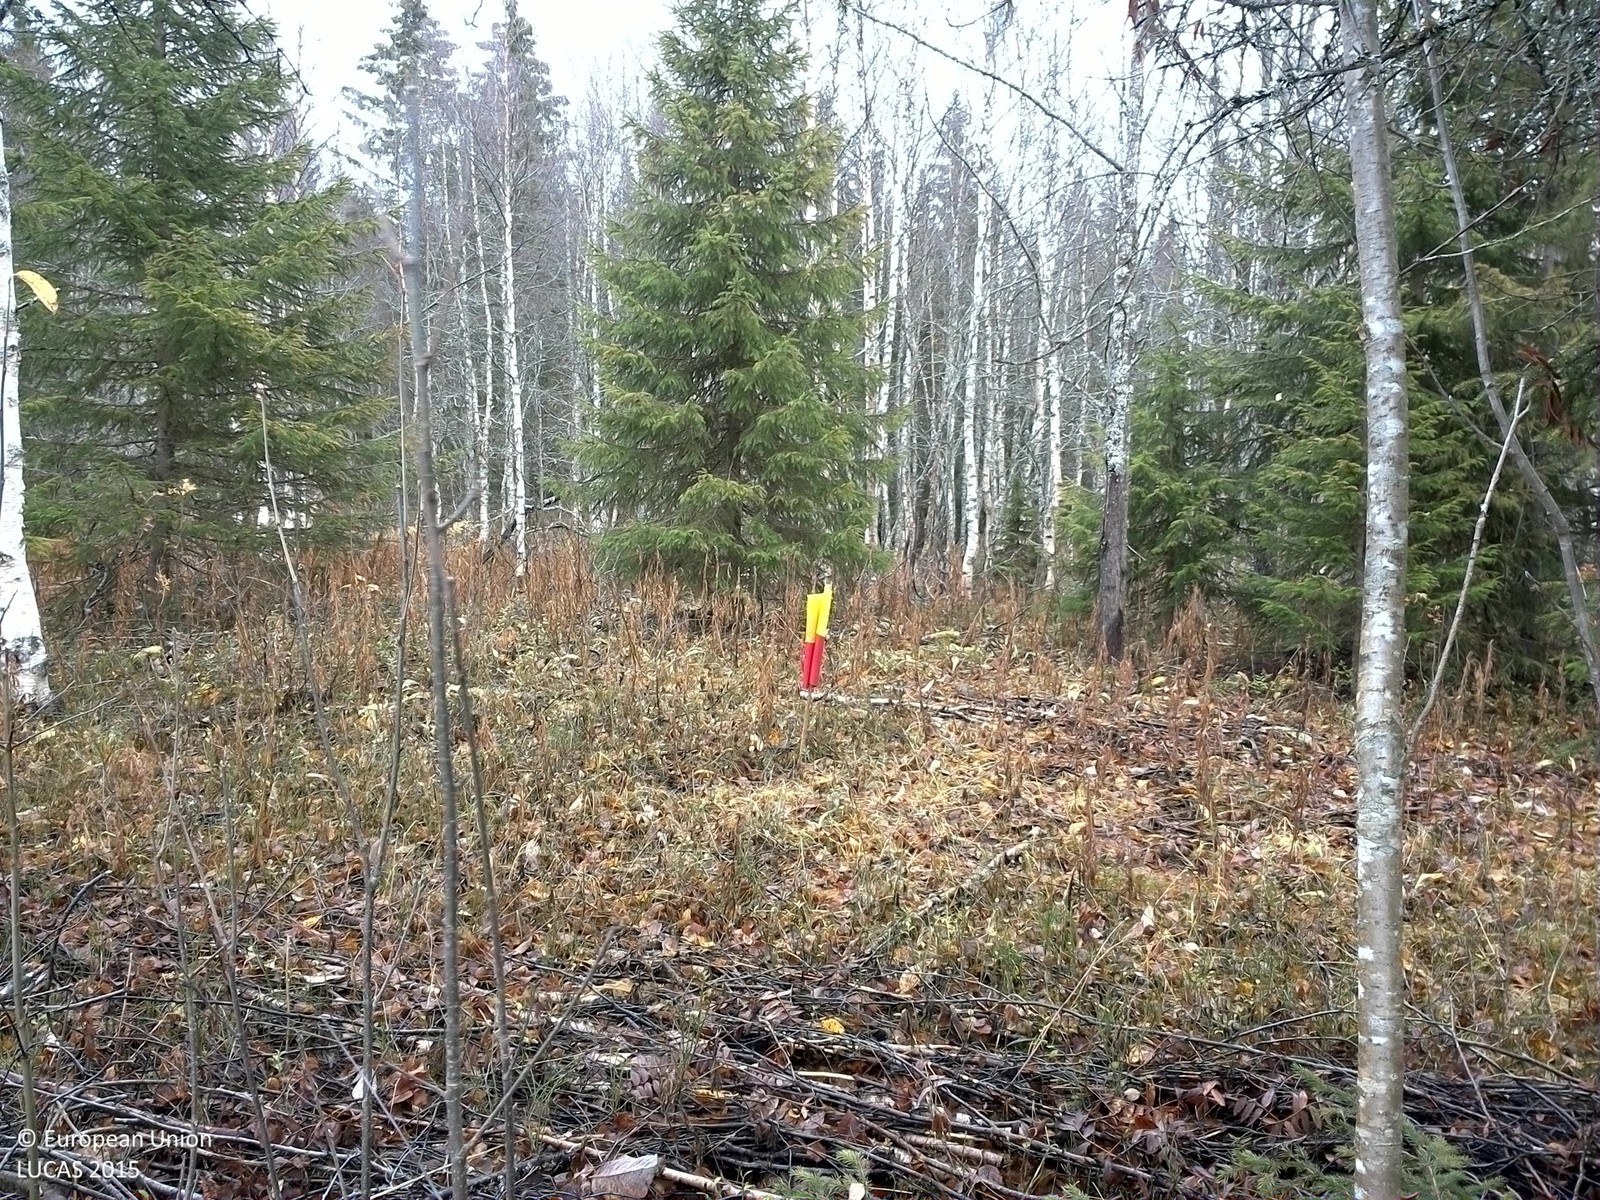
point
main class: Woodland
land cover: Spruce dominated mixed woodland
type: boreal forest
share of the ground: 50 - 75 %
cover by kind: broadleaved forest trees 55 %, coniferous forest trees 20 %, shrubs 15 %, lichens and mosses 10 %
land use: Forestry
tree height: > 5 m
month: October
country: SE
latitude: 64.7277
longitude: 13.9848
